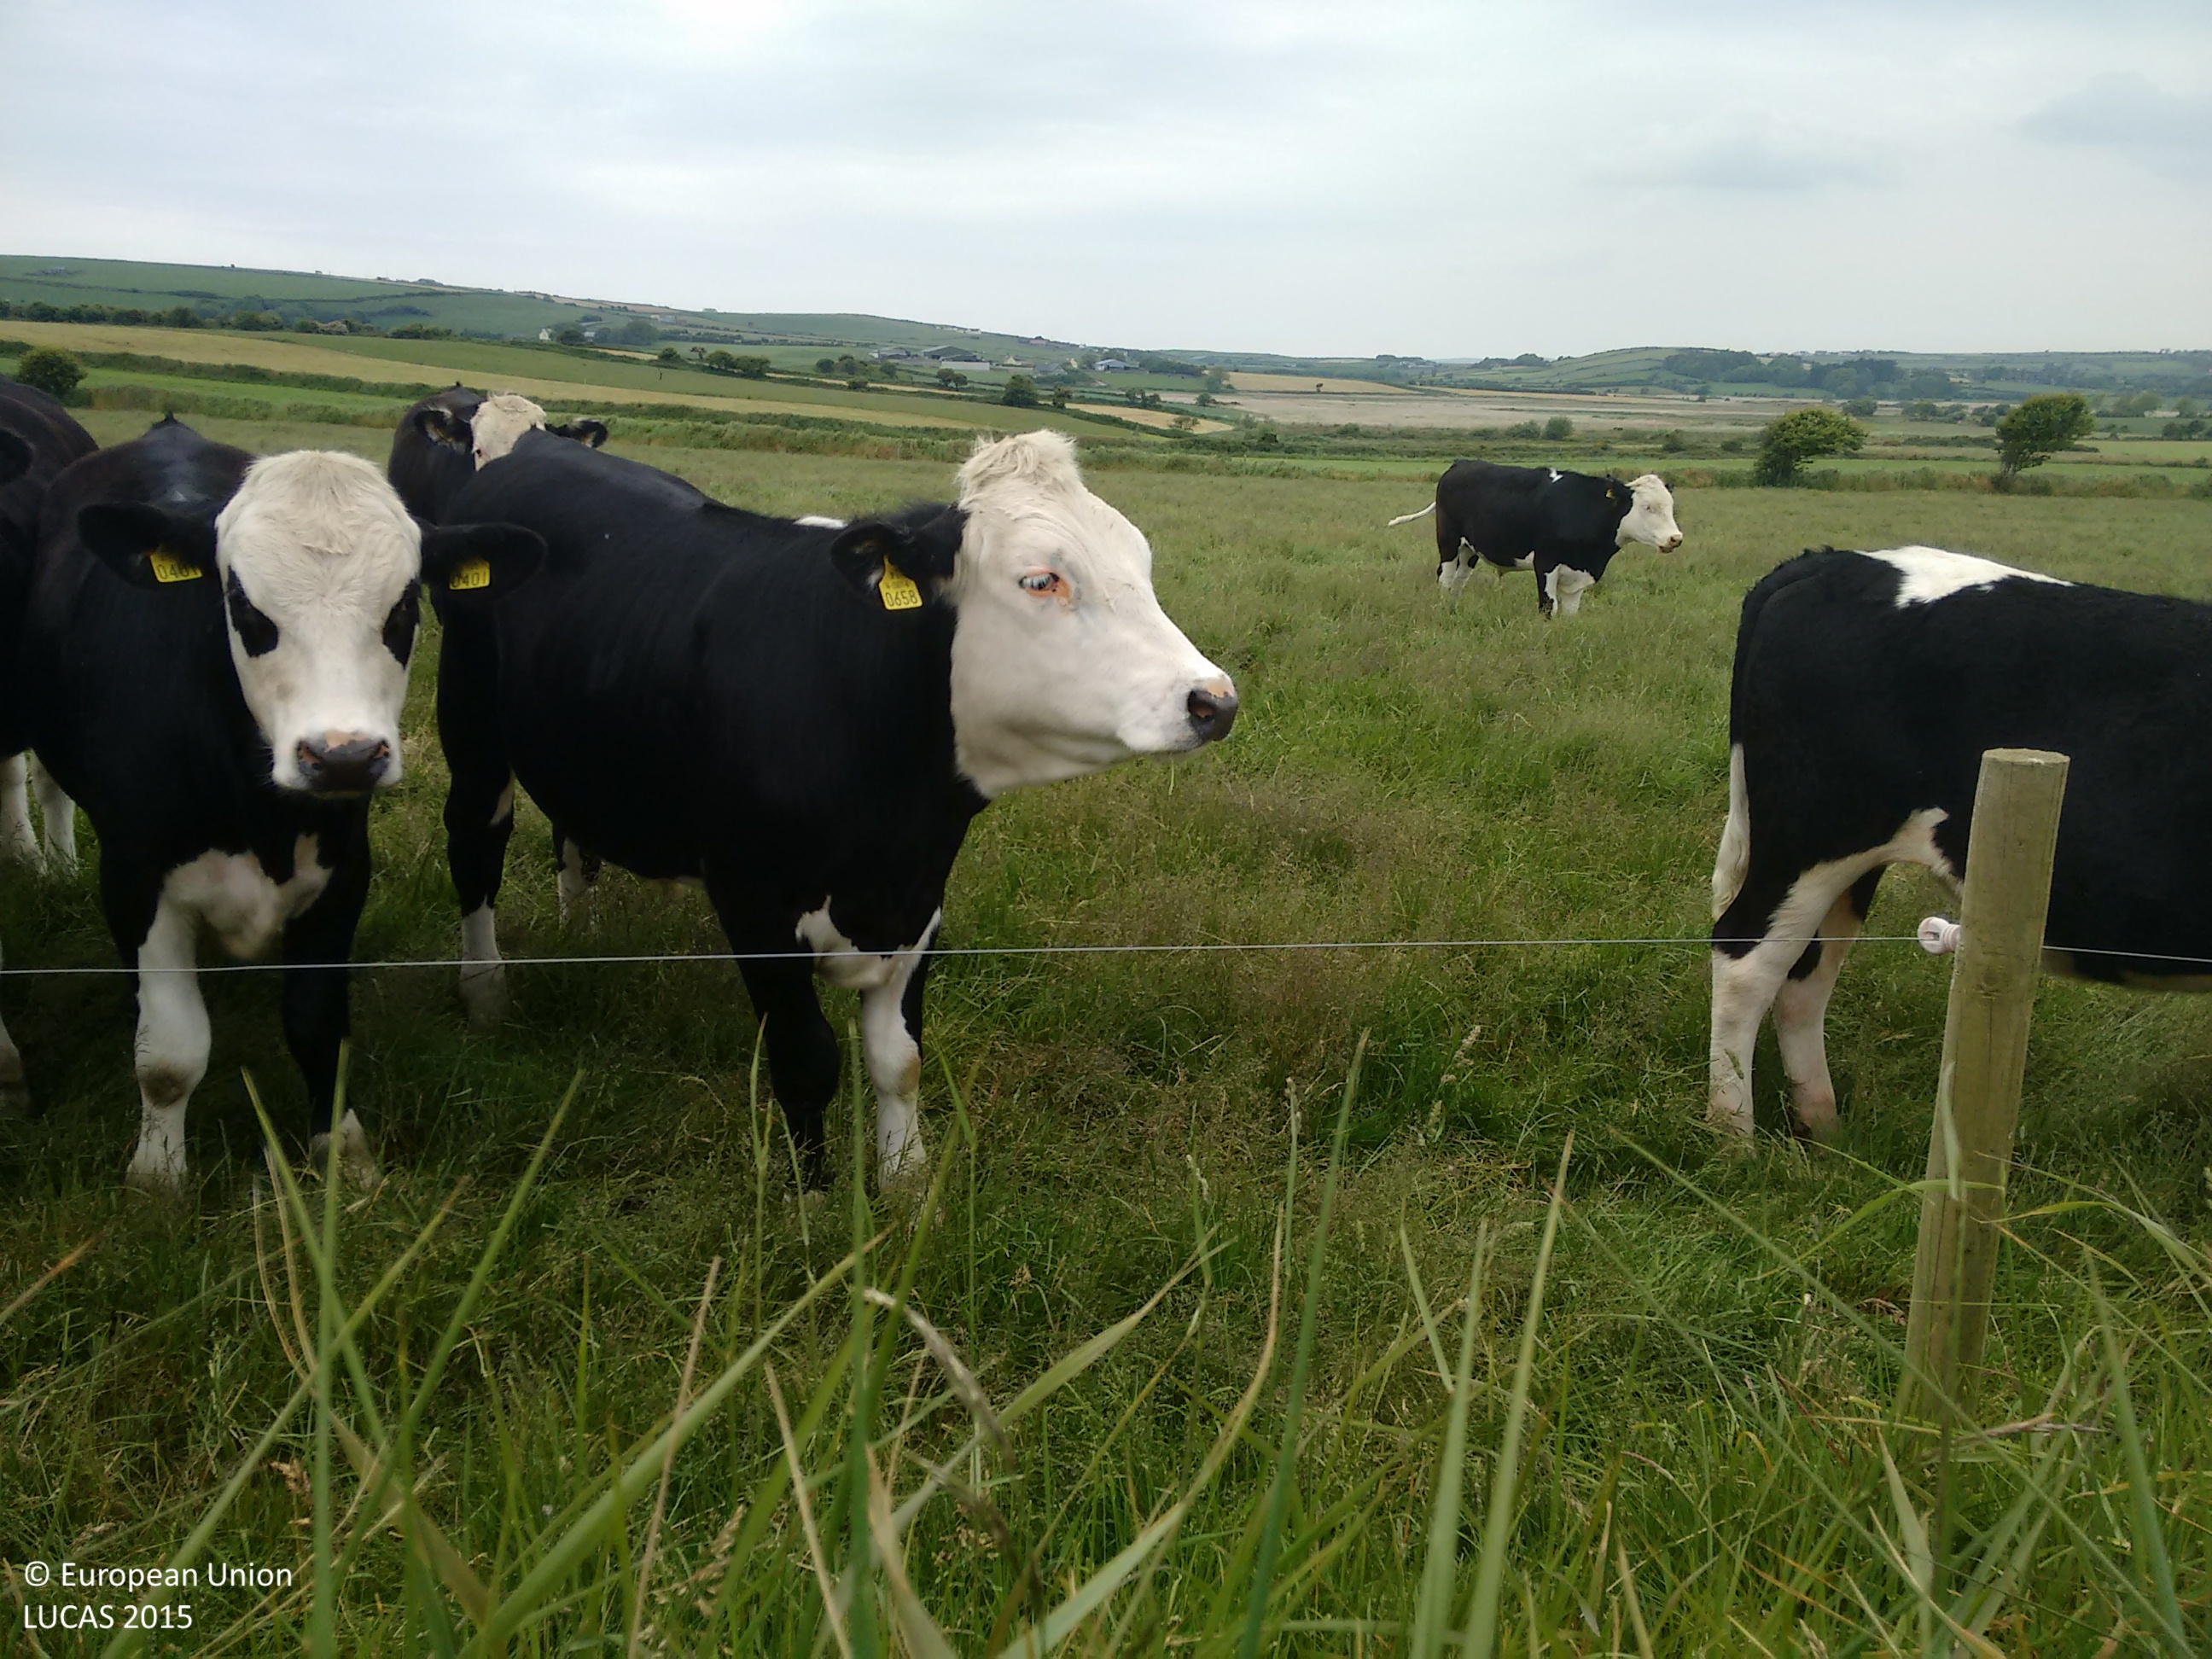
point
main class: Grassland
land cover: Grassland without tree/shrub cover
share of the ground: > 75 %
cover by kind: herbaceous plants 95 %, shrubs 5 %
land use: Agriculture (excluding fallow land and kitchen gardens)
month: June
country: IE
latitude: 51.6017
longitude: -8.7559
